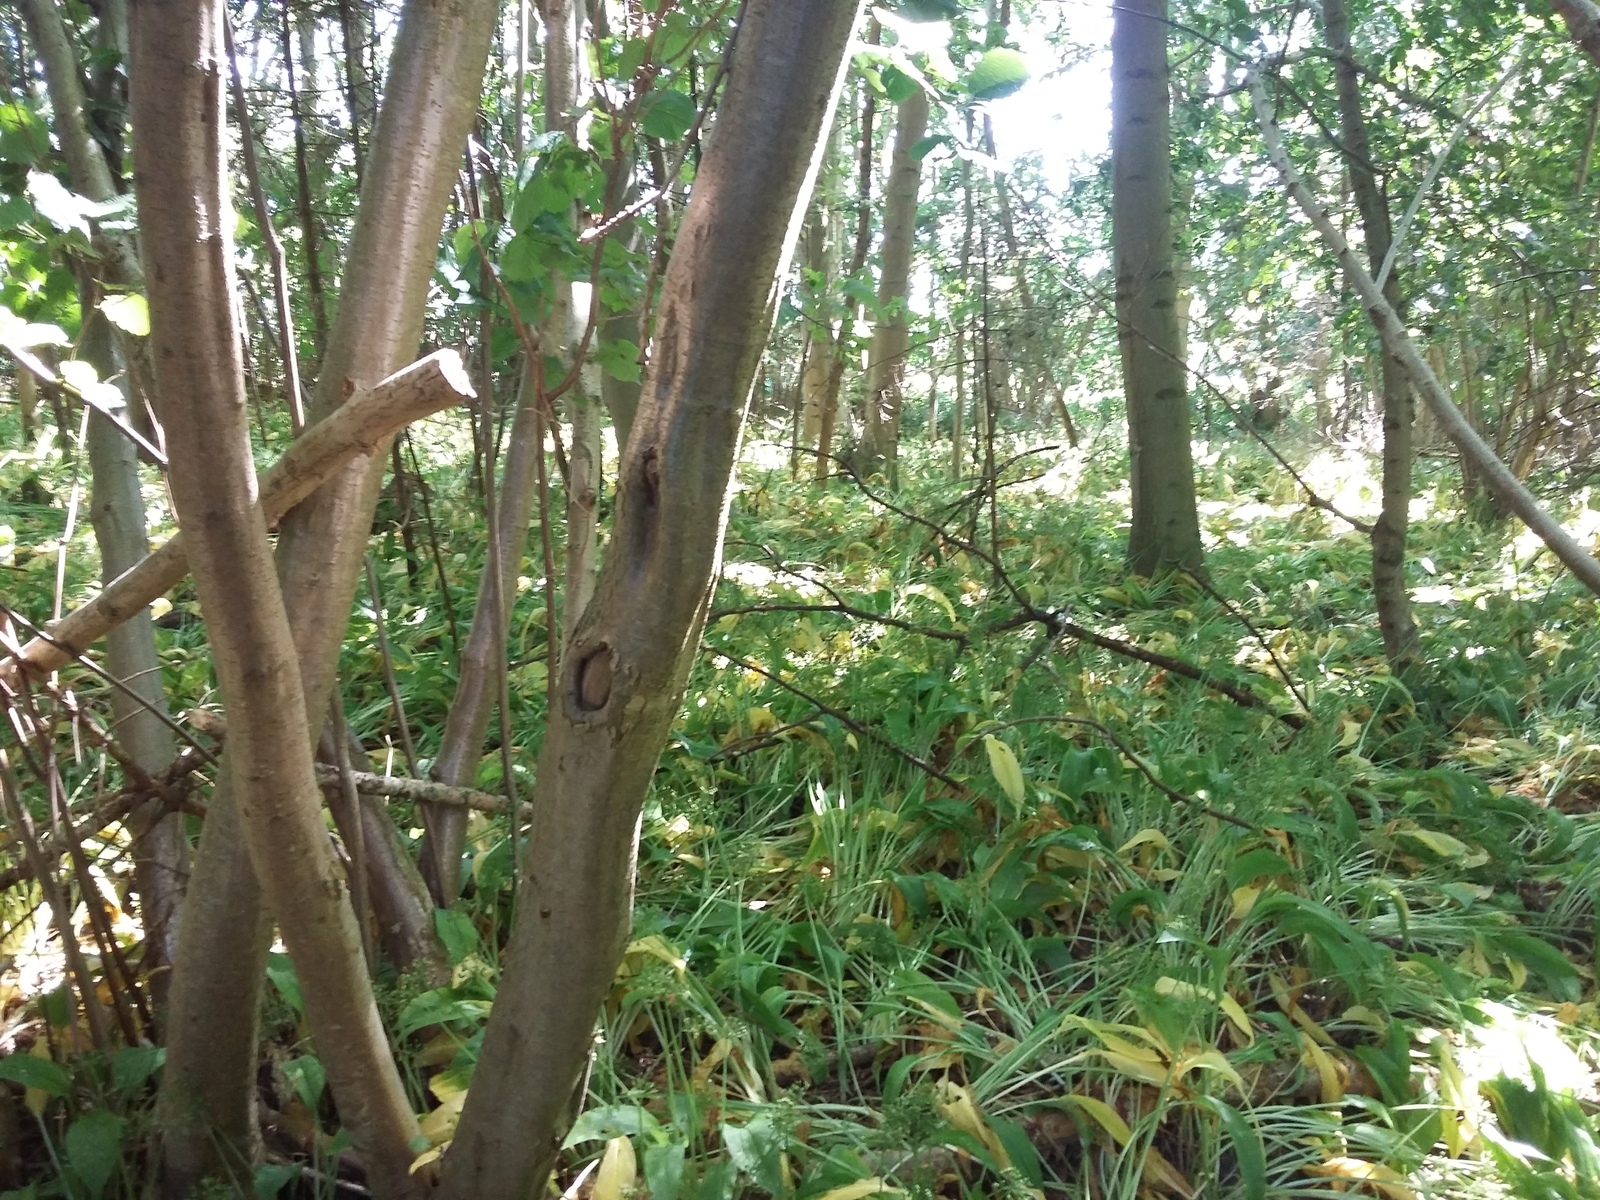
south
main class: Woodland
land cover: Broadleaved woodland
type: beech forest
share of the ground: > 75 %
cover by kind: broadleaved forest trees 80 %, coniferous forest trees 10 %, herbaceous plants 10 %
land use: Forestry
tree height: > 5 m
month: July
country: DK
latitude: 55.0392
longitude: 12.0173
